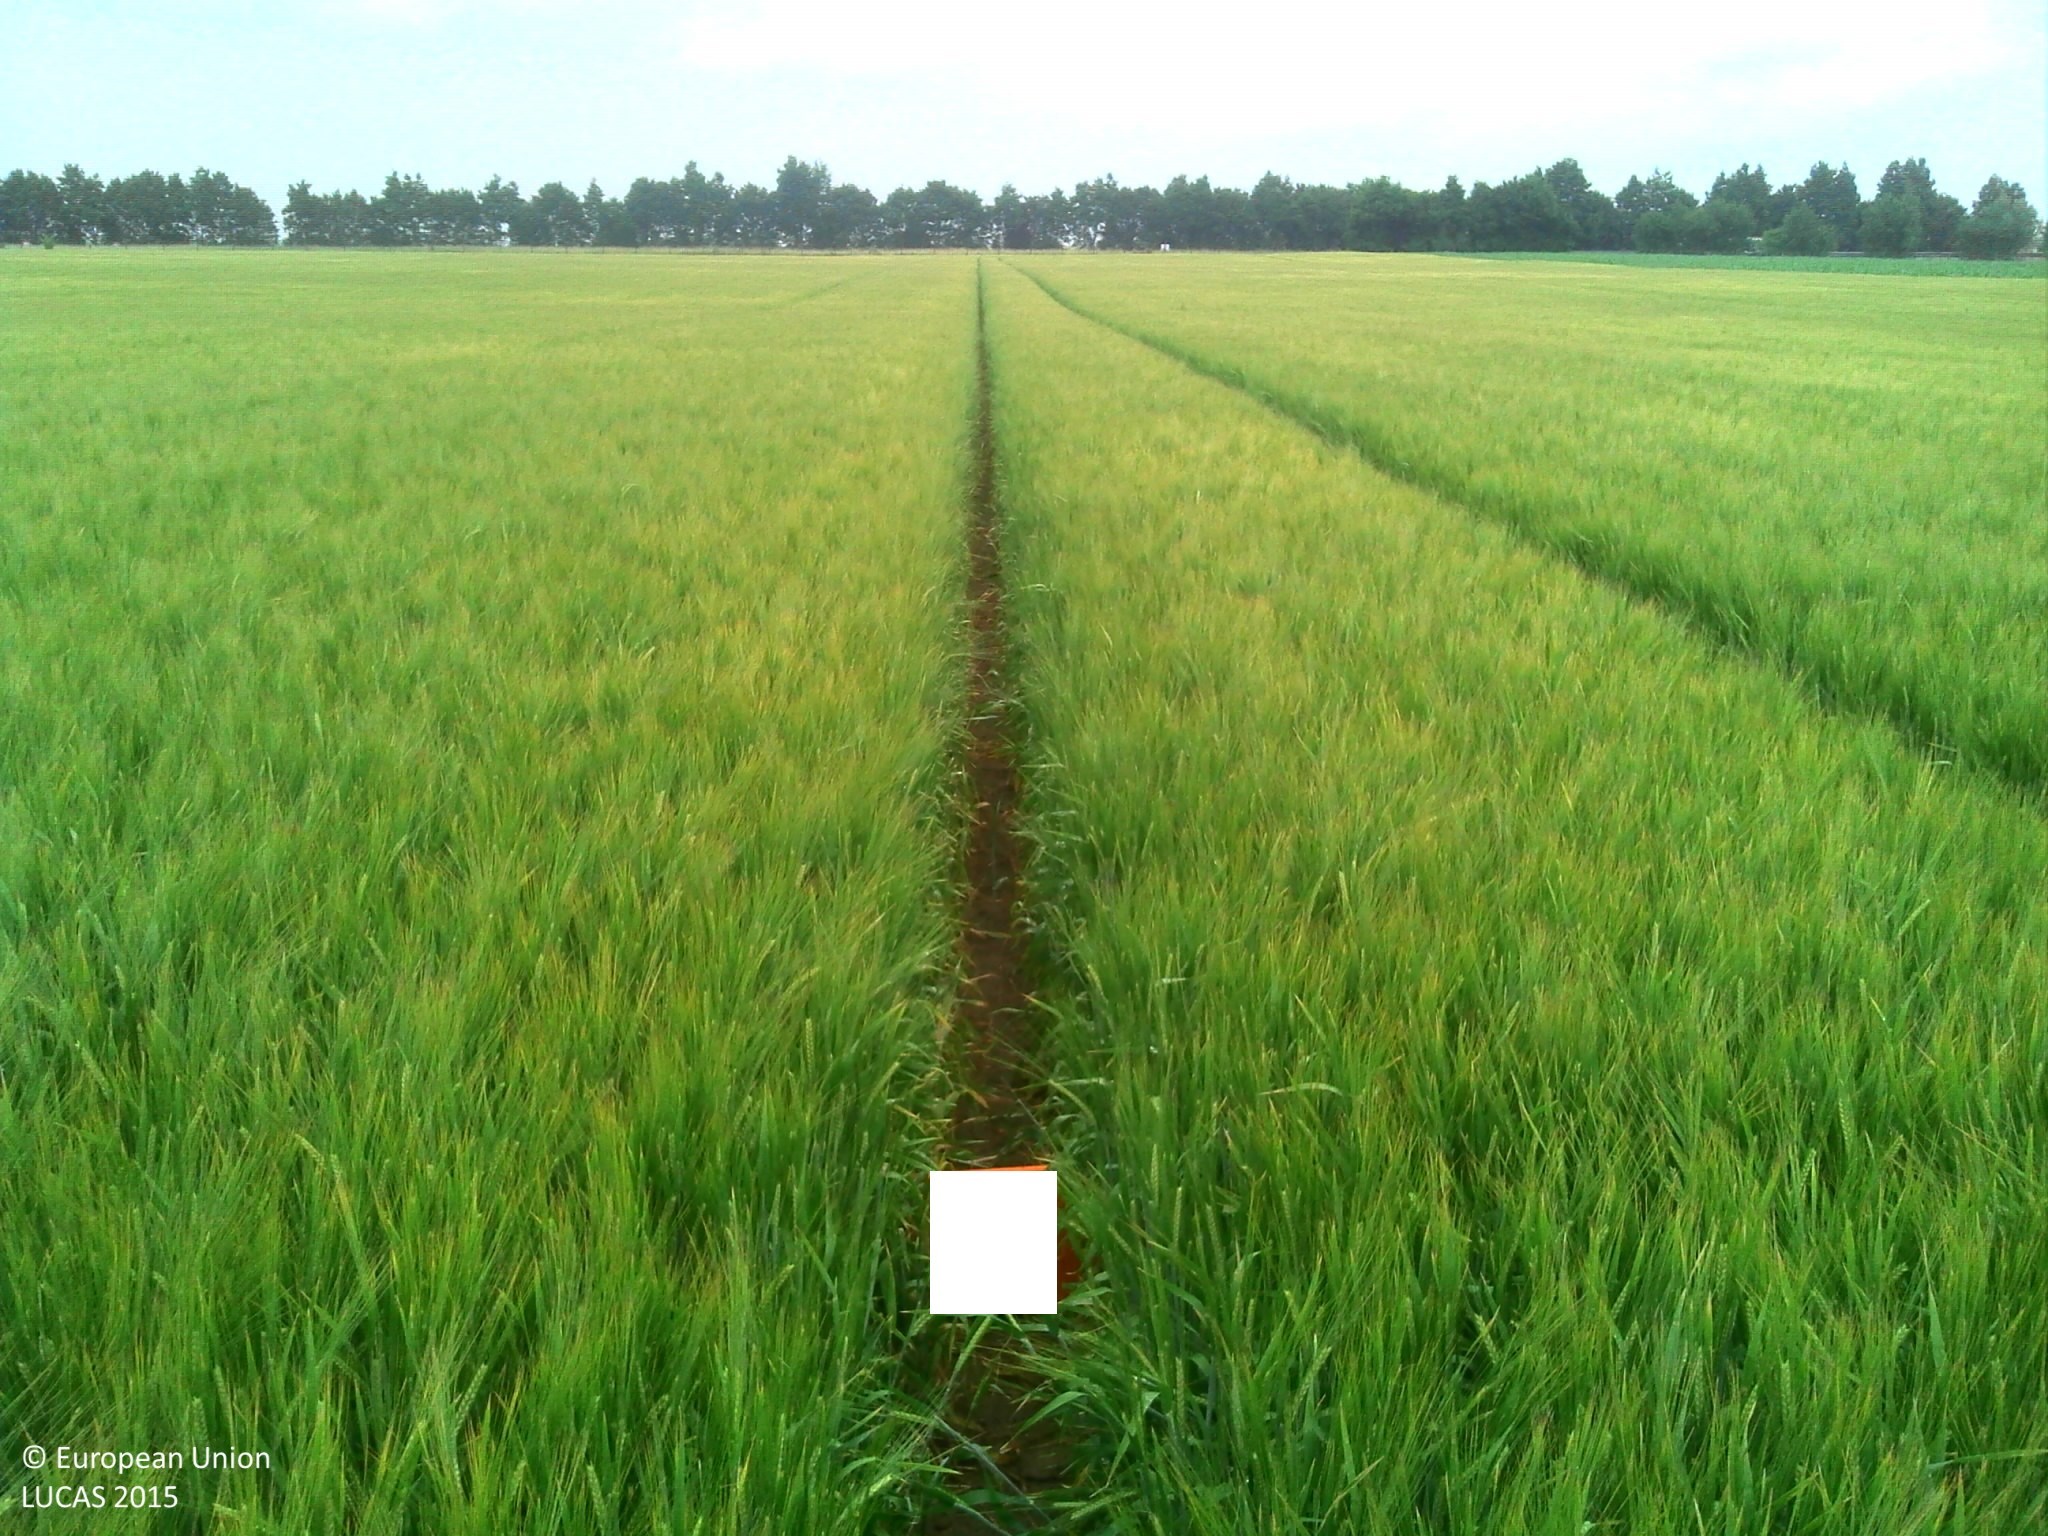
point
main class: Cropland
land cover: Barley
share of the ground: > 75 %
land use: Agriculture (excluding fallow land and kitchen gardens)
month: June
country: FR
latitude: 49.5935
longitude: 3.6711
